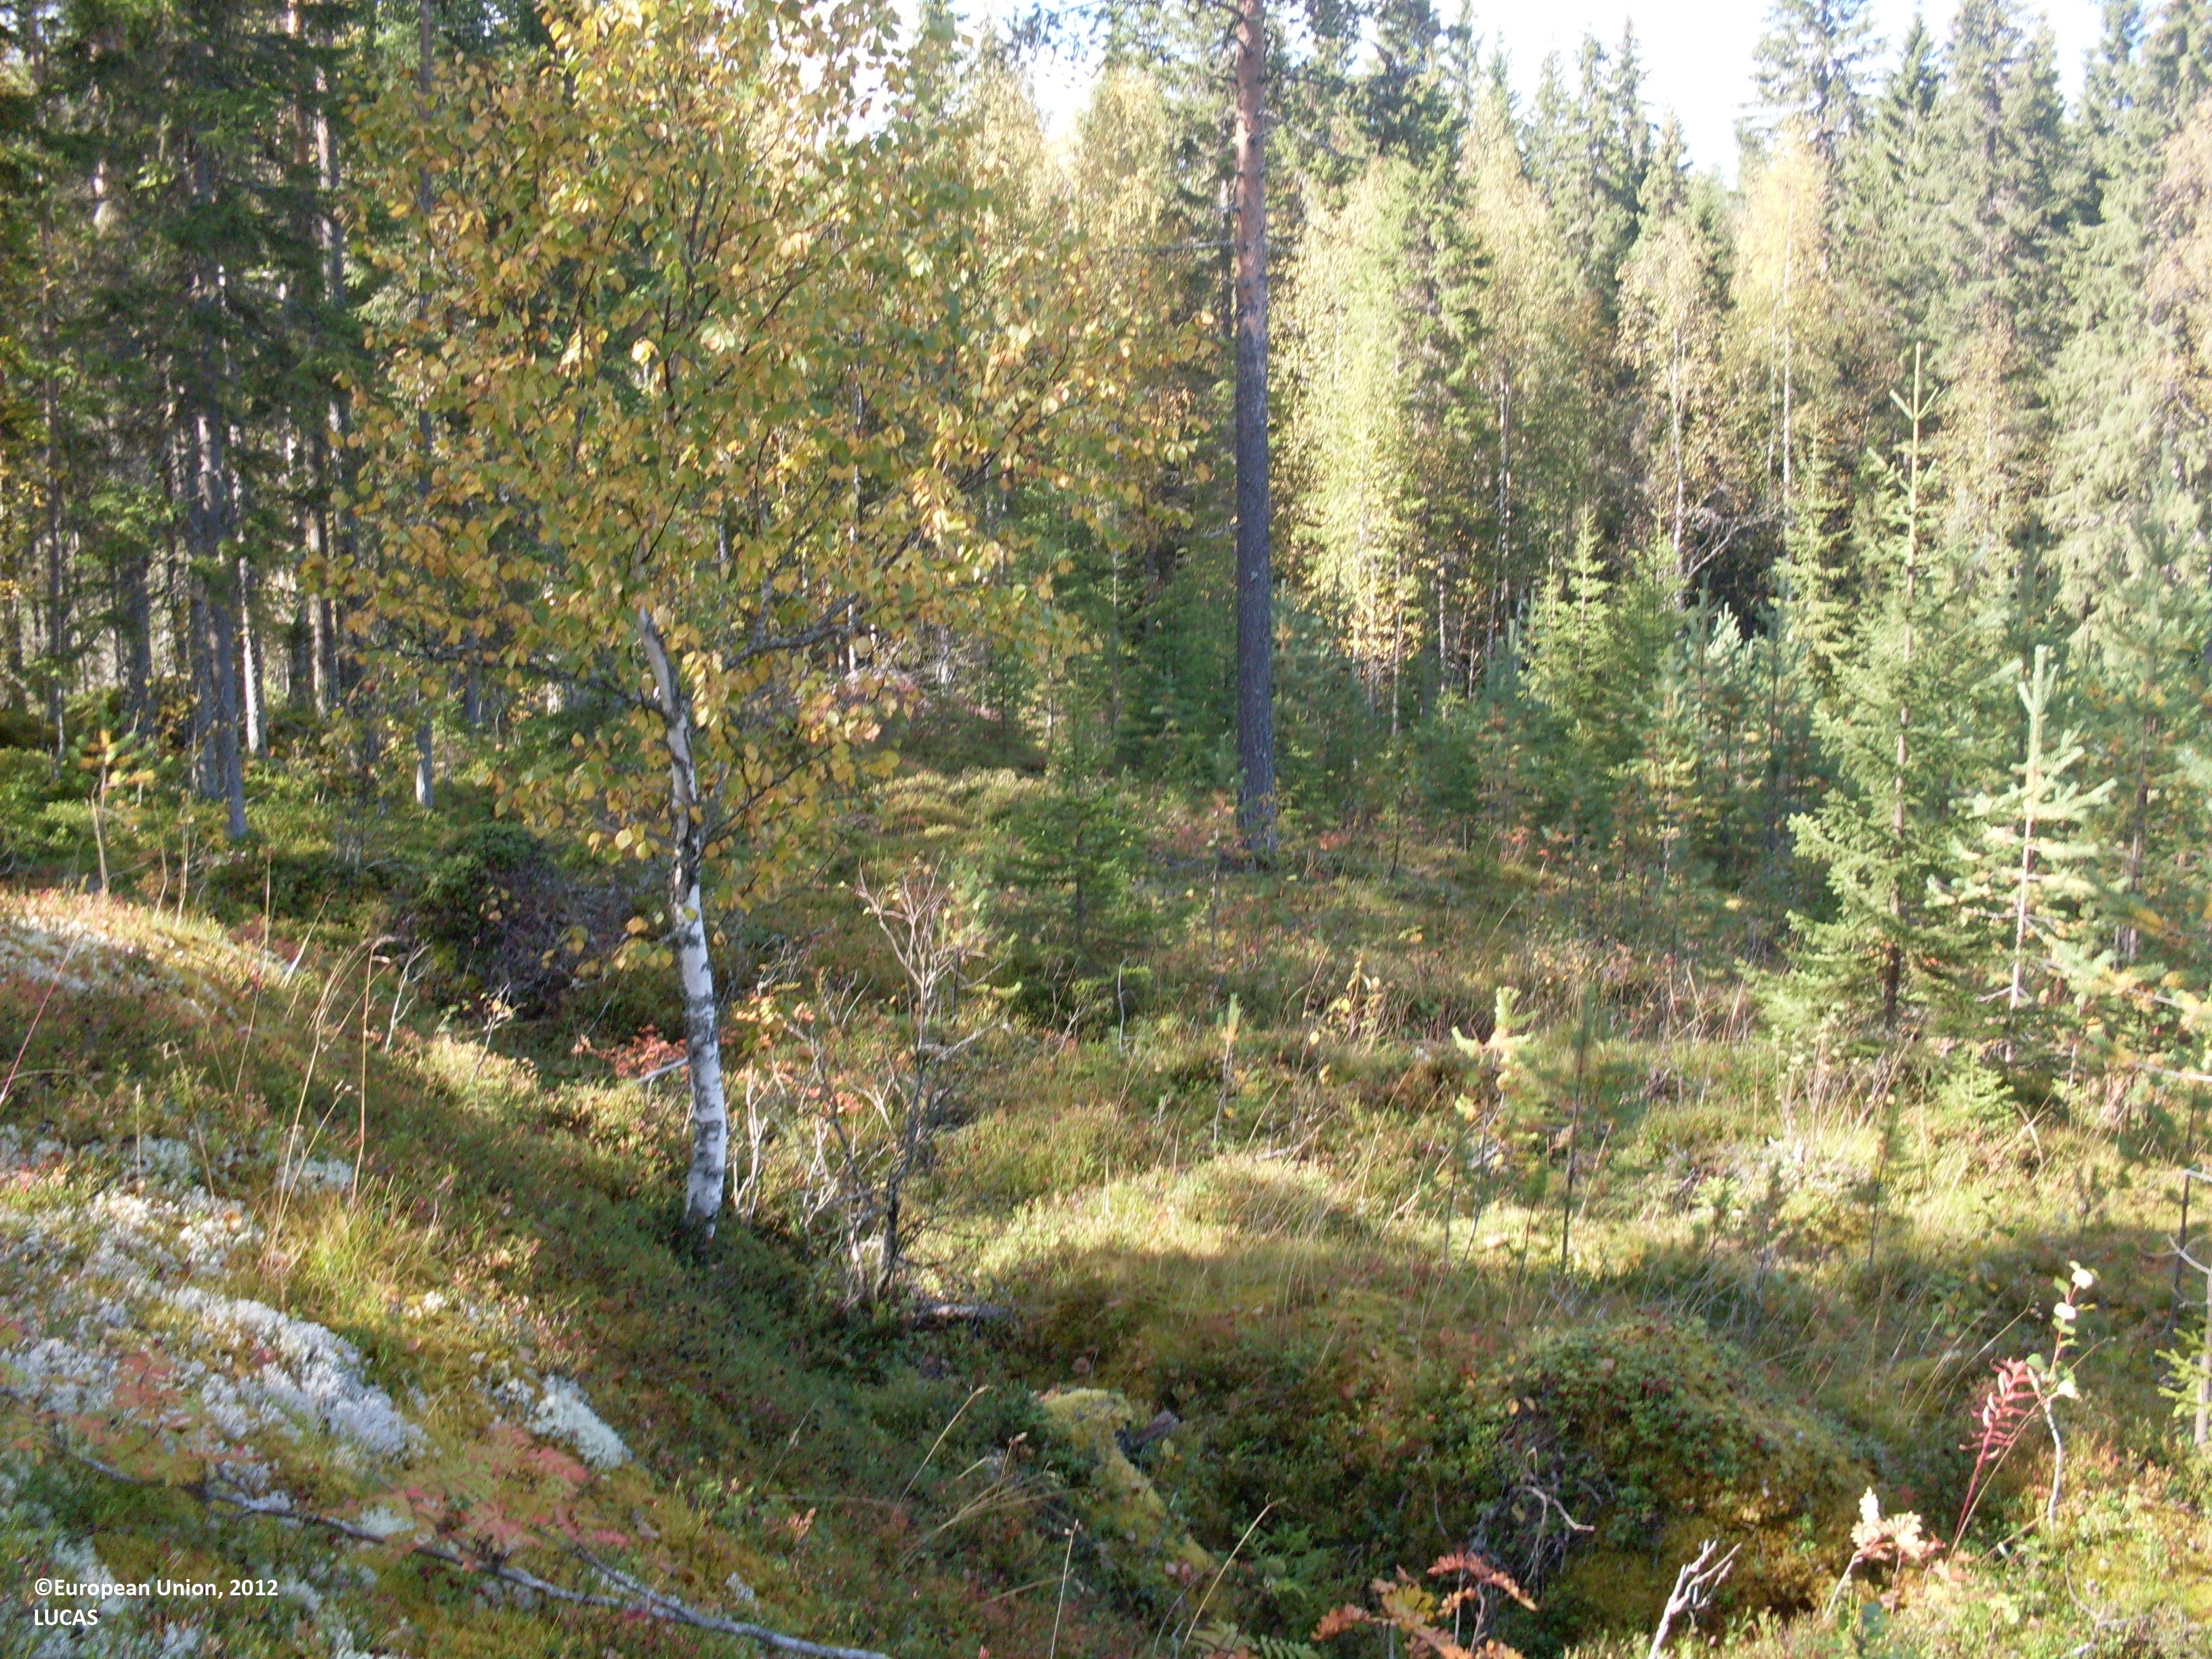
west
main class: Woodland
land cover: Pine dominated coniferous woodland
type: boreal forest
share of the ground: 50 - 75 %
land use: Forestry
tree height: > 5 m
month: September
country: FI
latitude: 64.1023
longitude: 29.9584
